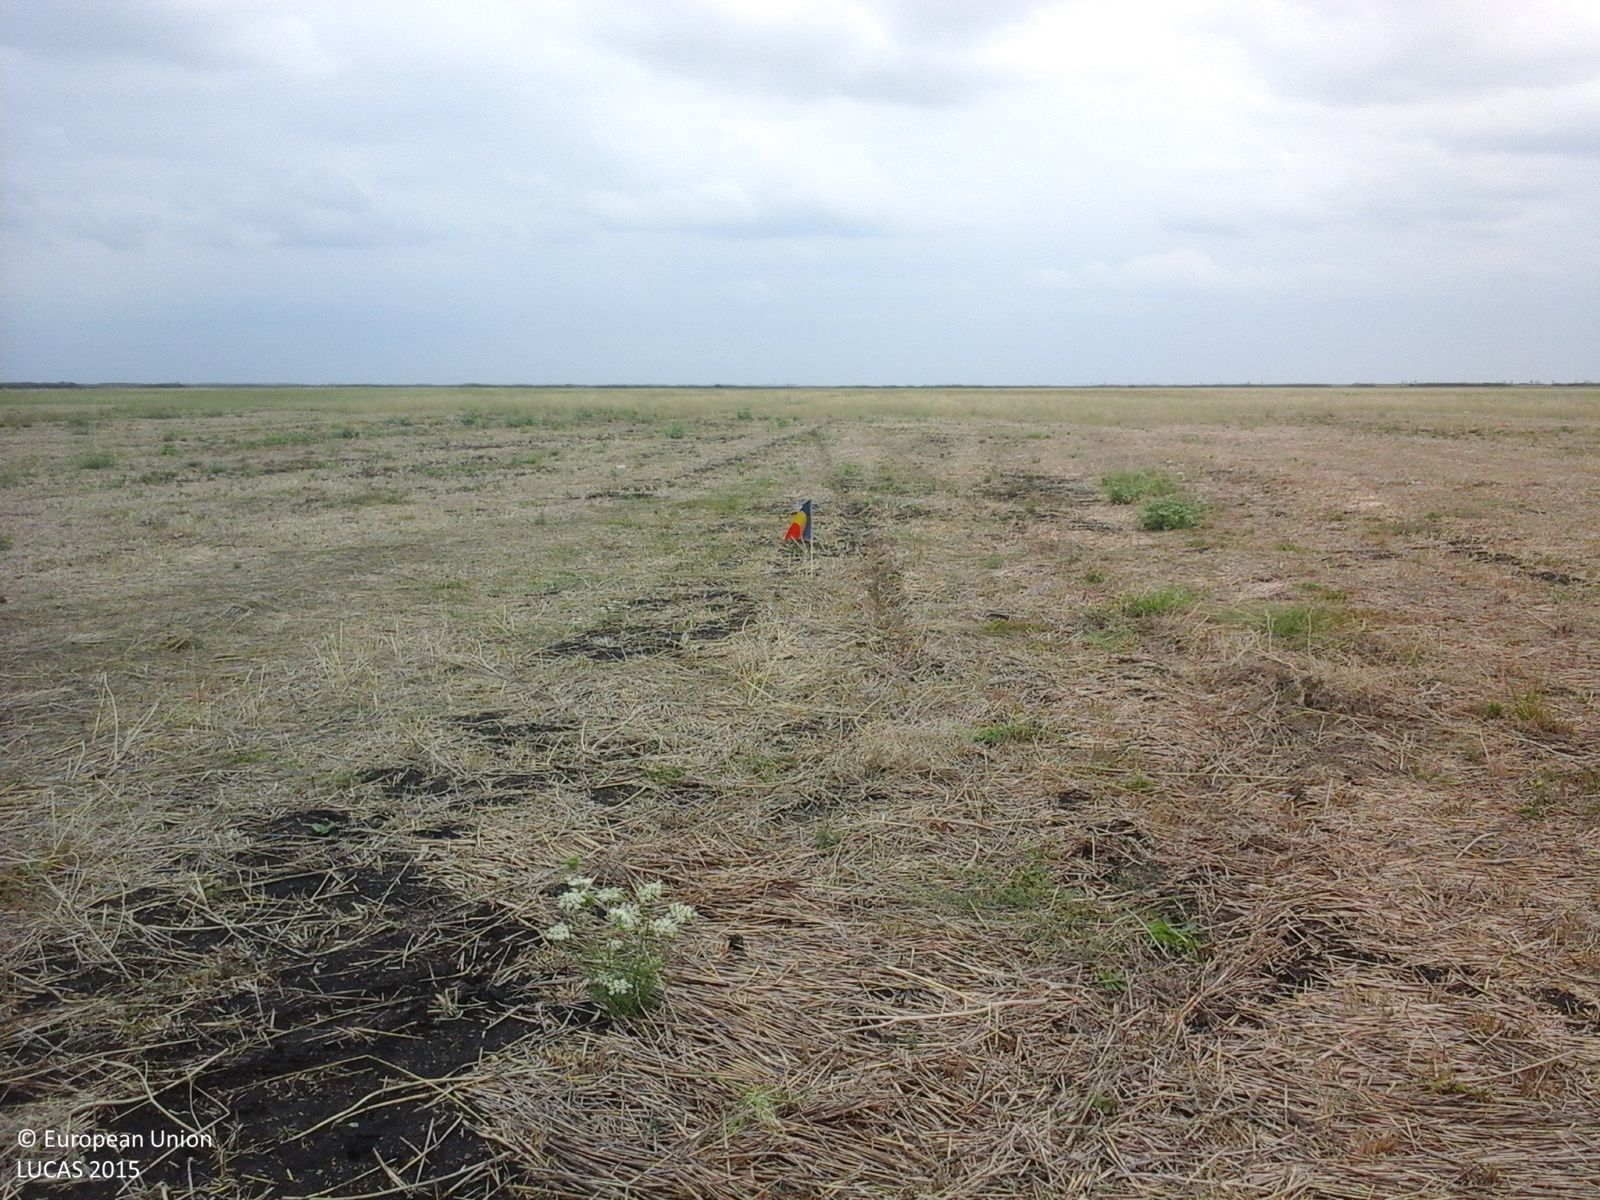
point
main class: Cropland
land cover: Common wheat
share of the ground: 25 - 50 %
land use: Agriculture (excluding fallow land and kitchen gardens)
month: August
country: RO
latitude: 46.0298
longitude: 20.3453
